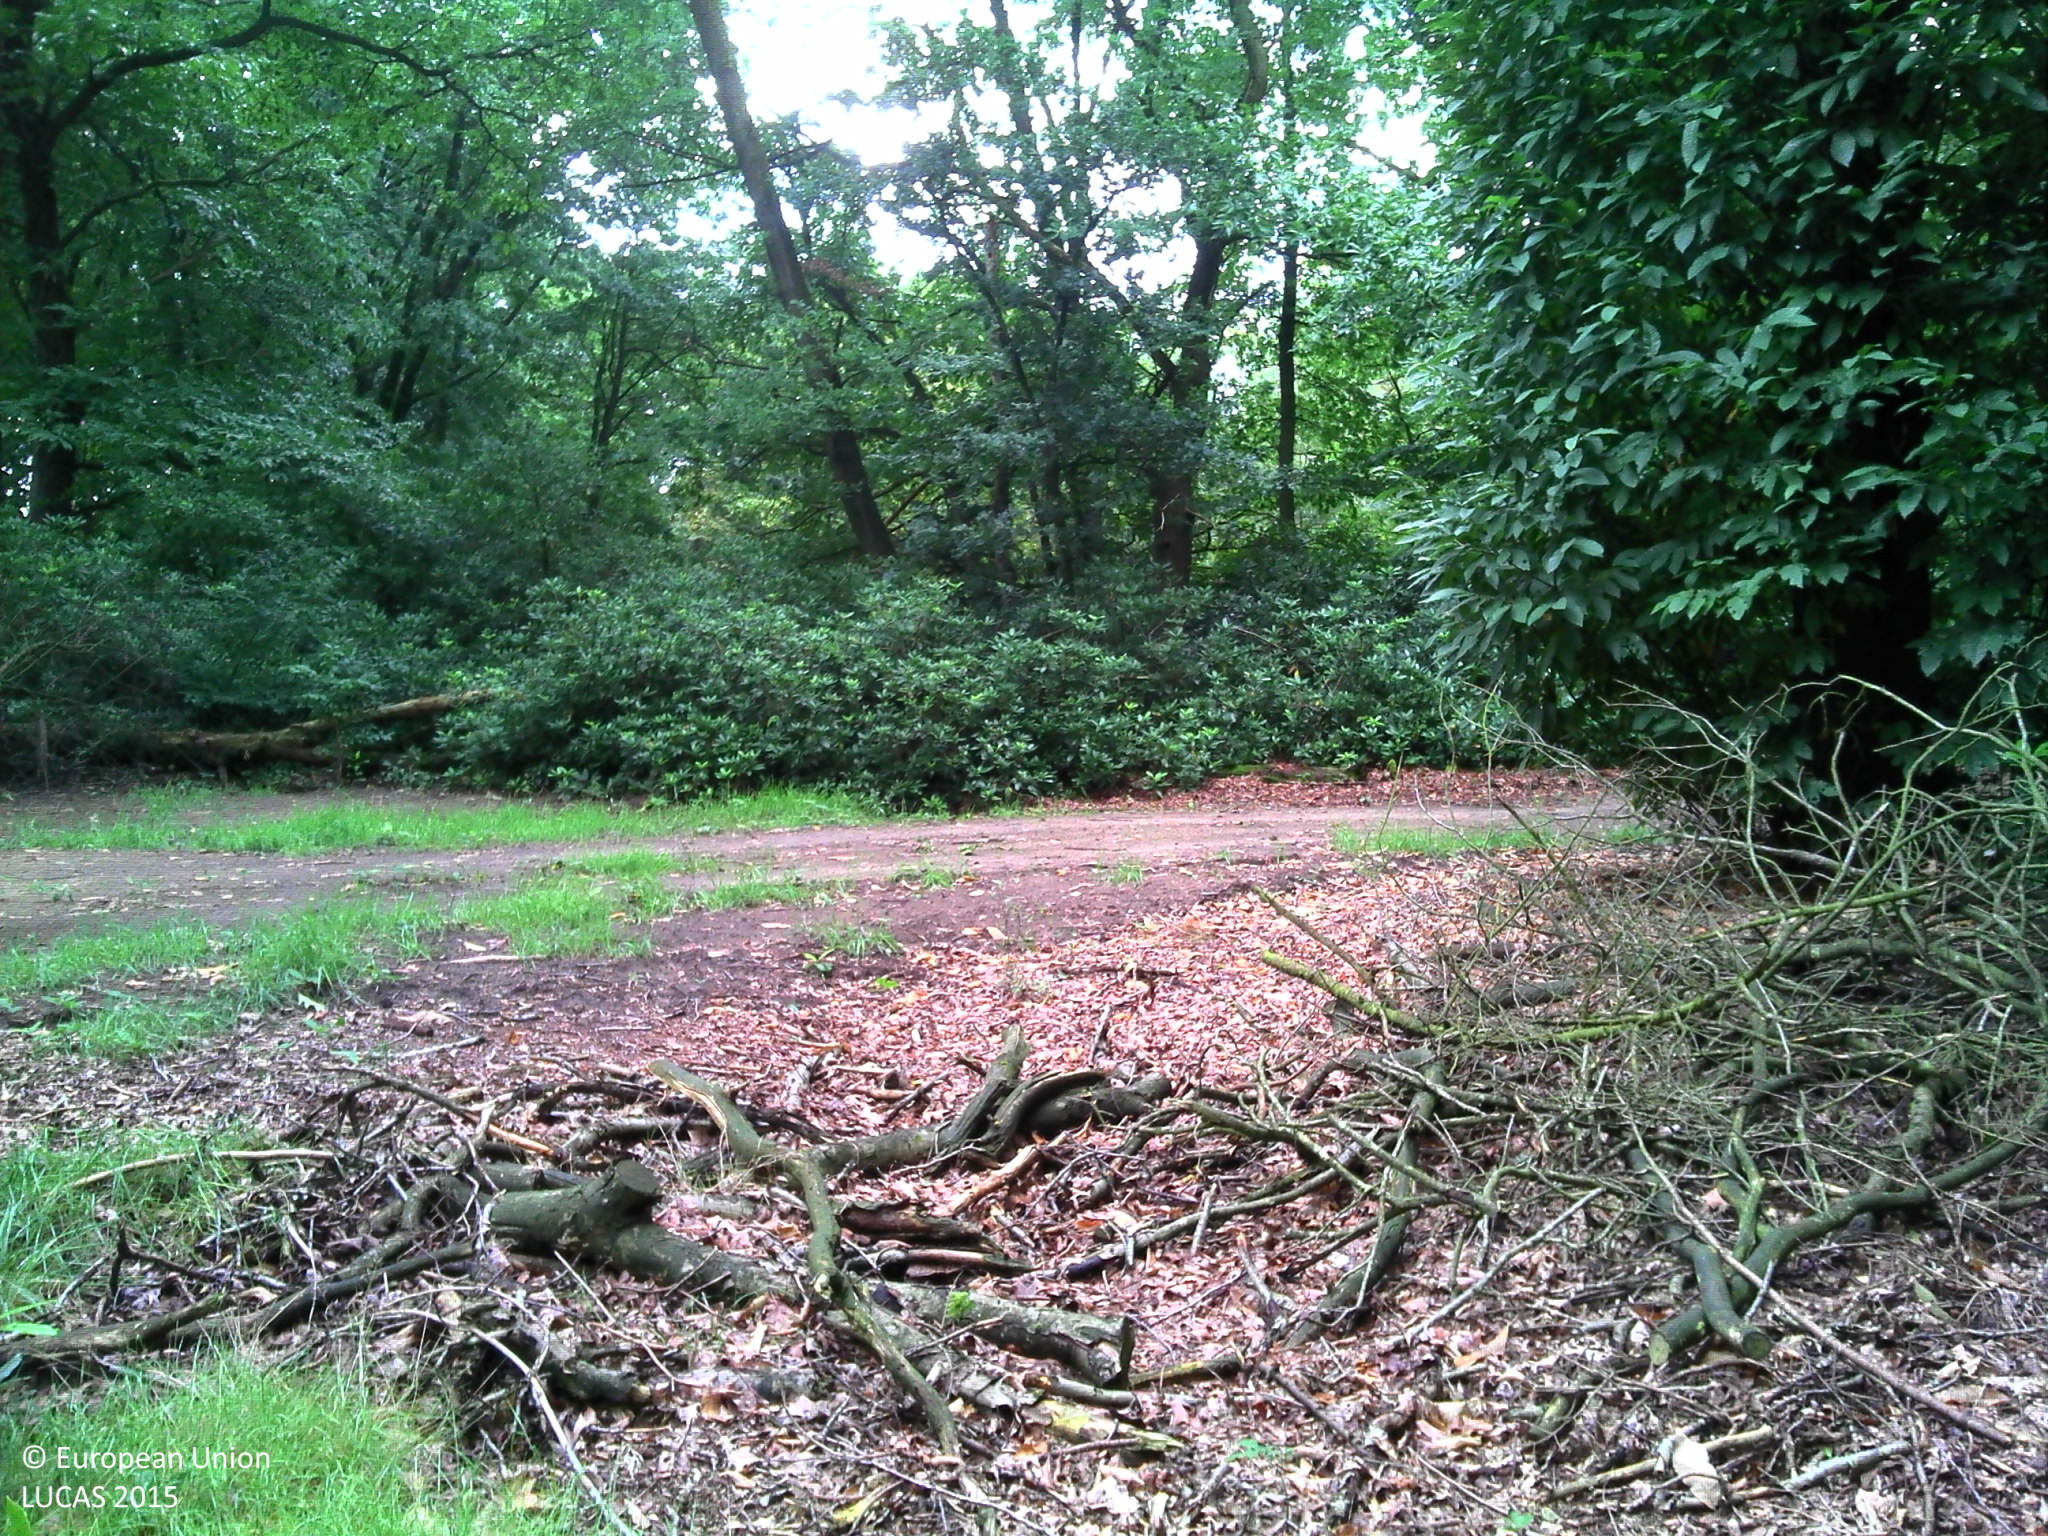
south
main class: Woodland
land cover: Broadleaved woodland
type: acidophilous oak and oak-birch forest
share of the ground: > 75 %
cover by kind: broadleaved forest trees 70 %, shrubs 20 %, herbaceous plants 10 %
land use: Forestry
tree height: > 5 m
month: September
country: BE
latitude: 51.4041
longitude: 4.5189
